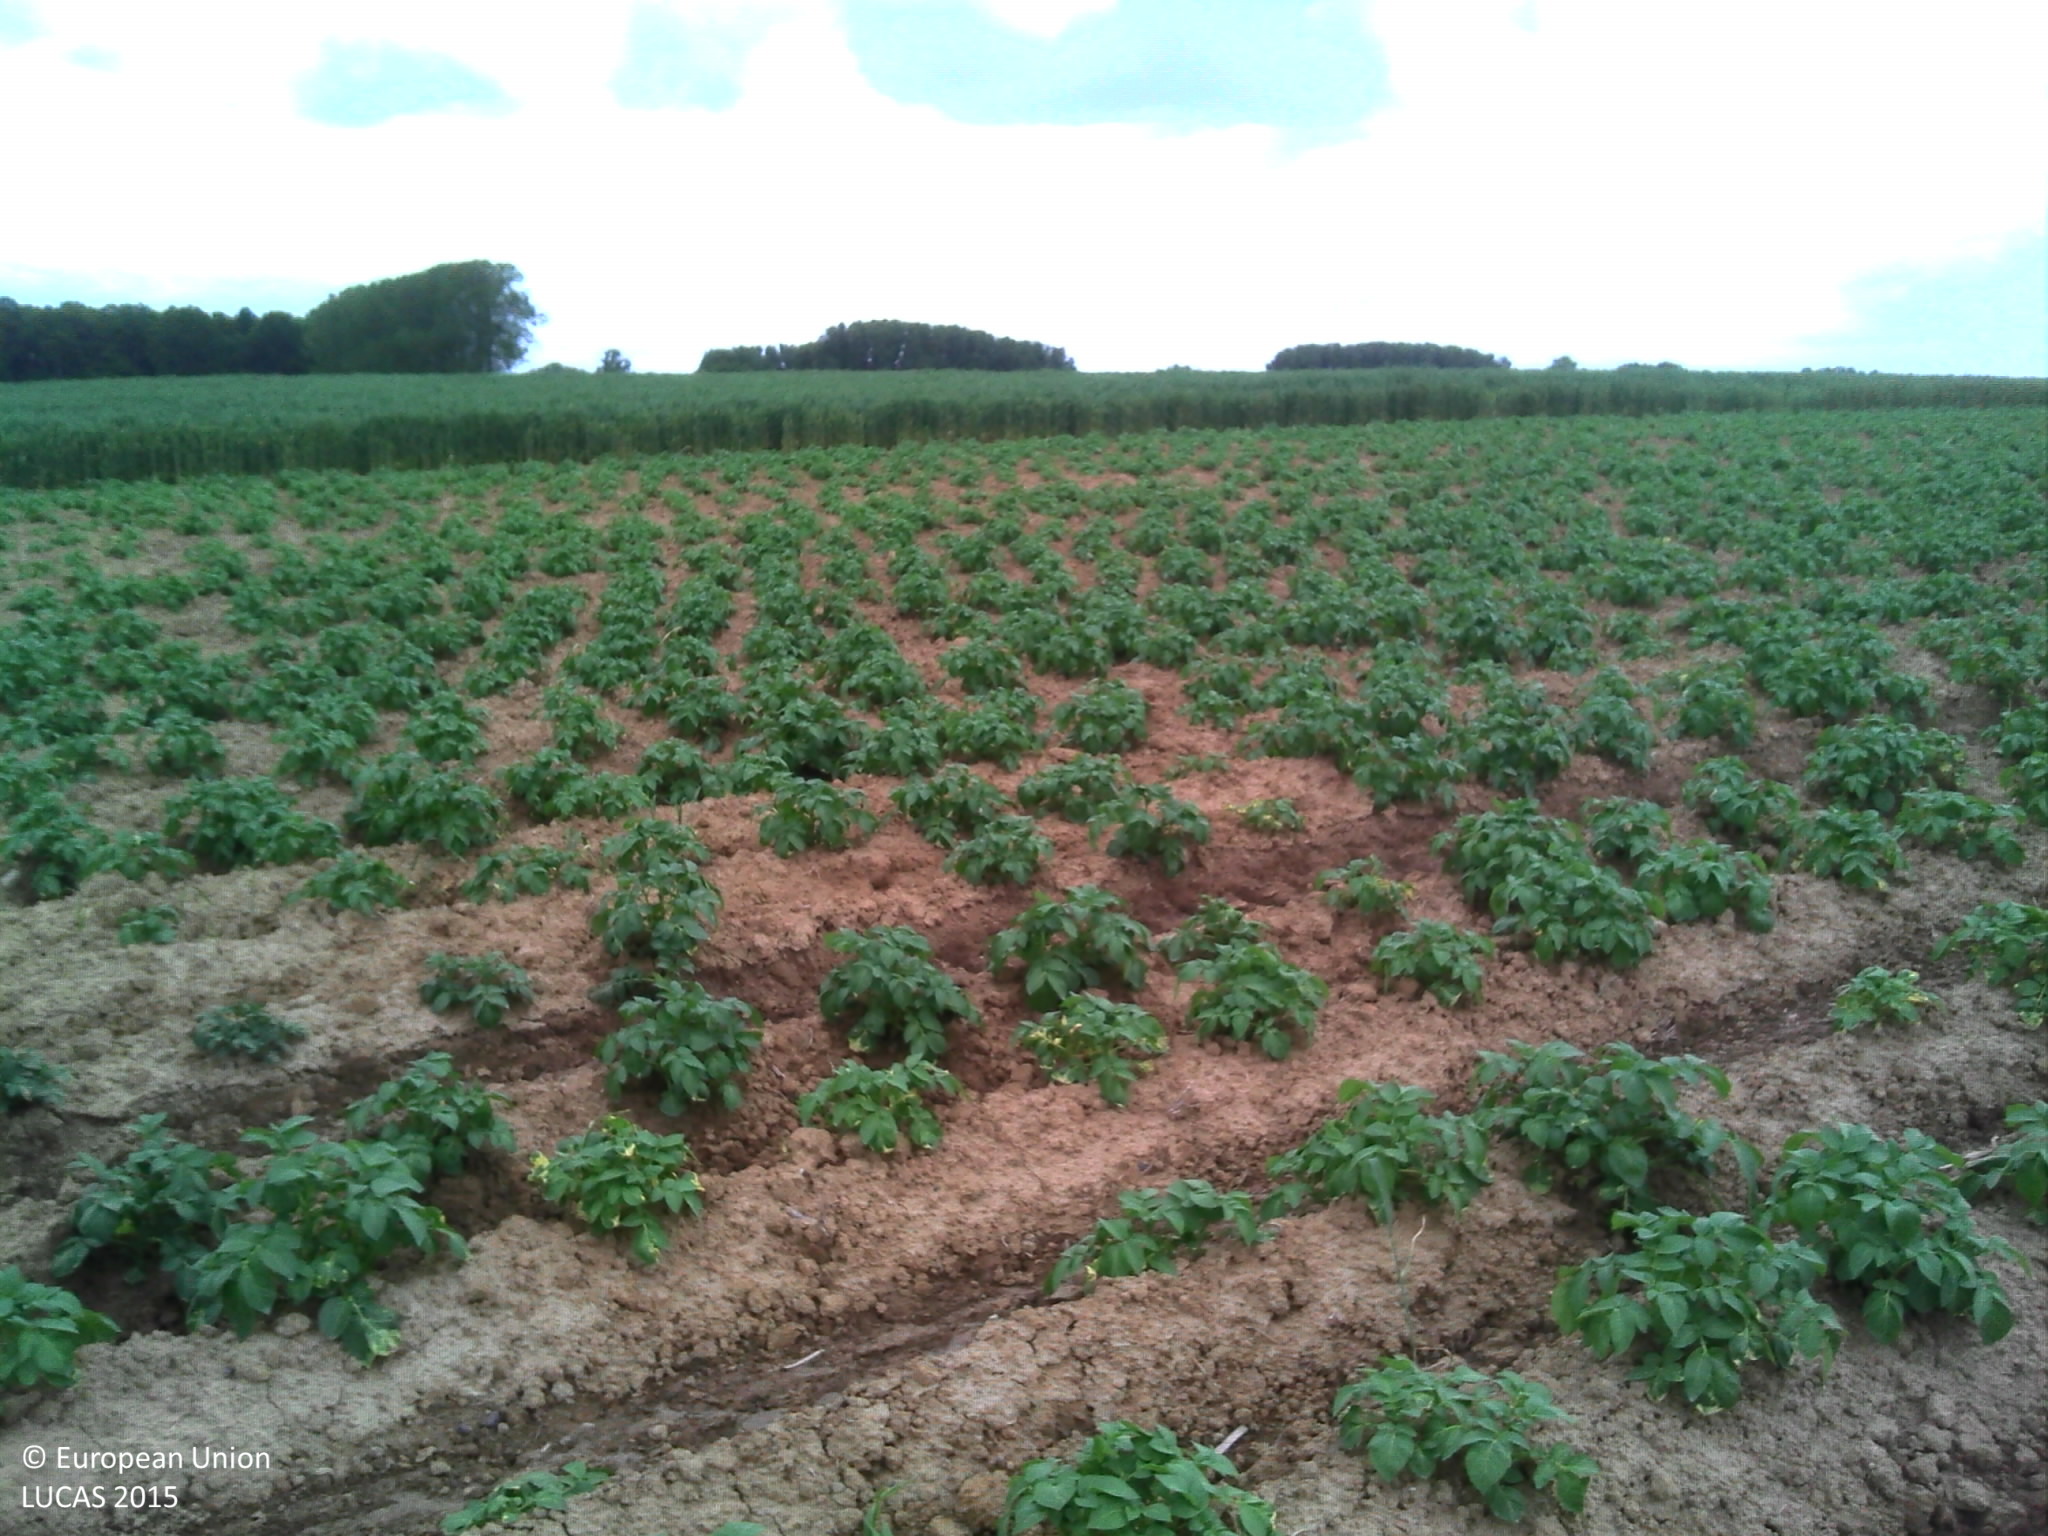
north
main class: Cropland
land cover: Potatoes
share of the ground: 50 - 75 %
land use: Agriculture (excluding fallow land and kitchen gardens)
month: June
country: BE
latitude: 50.8877
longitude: 3.9239
